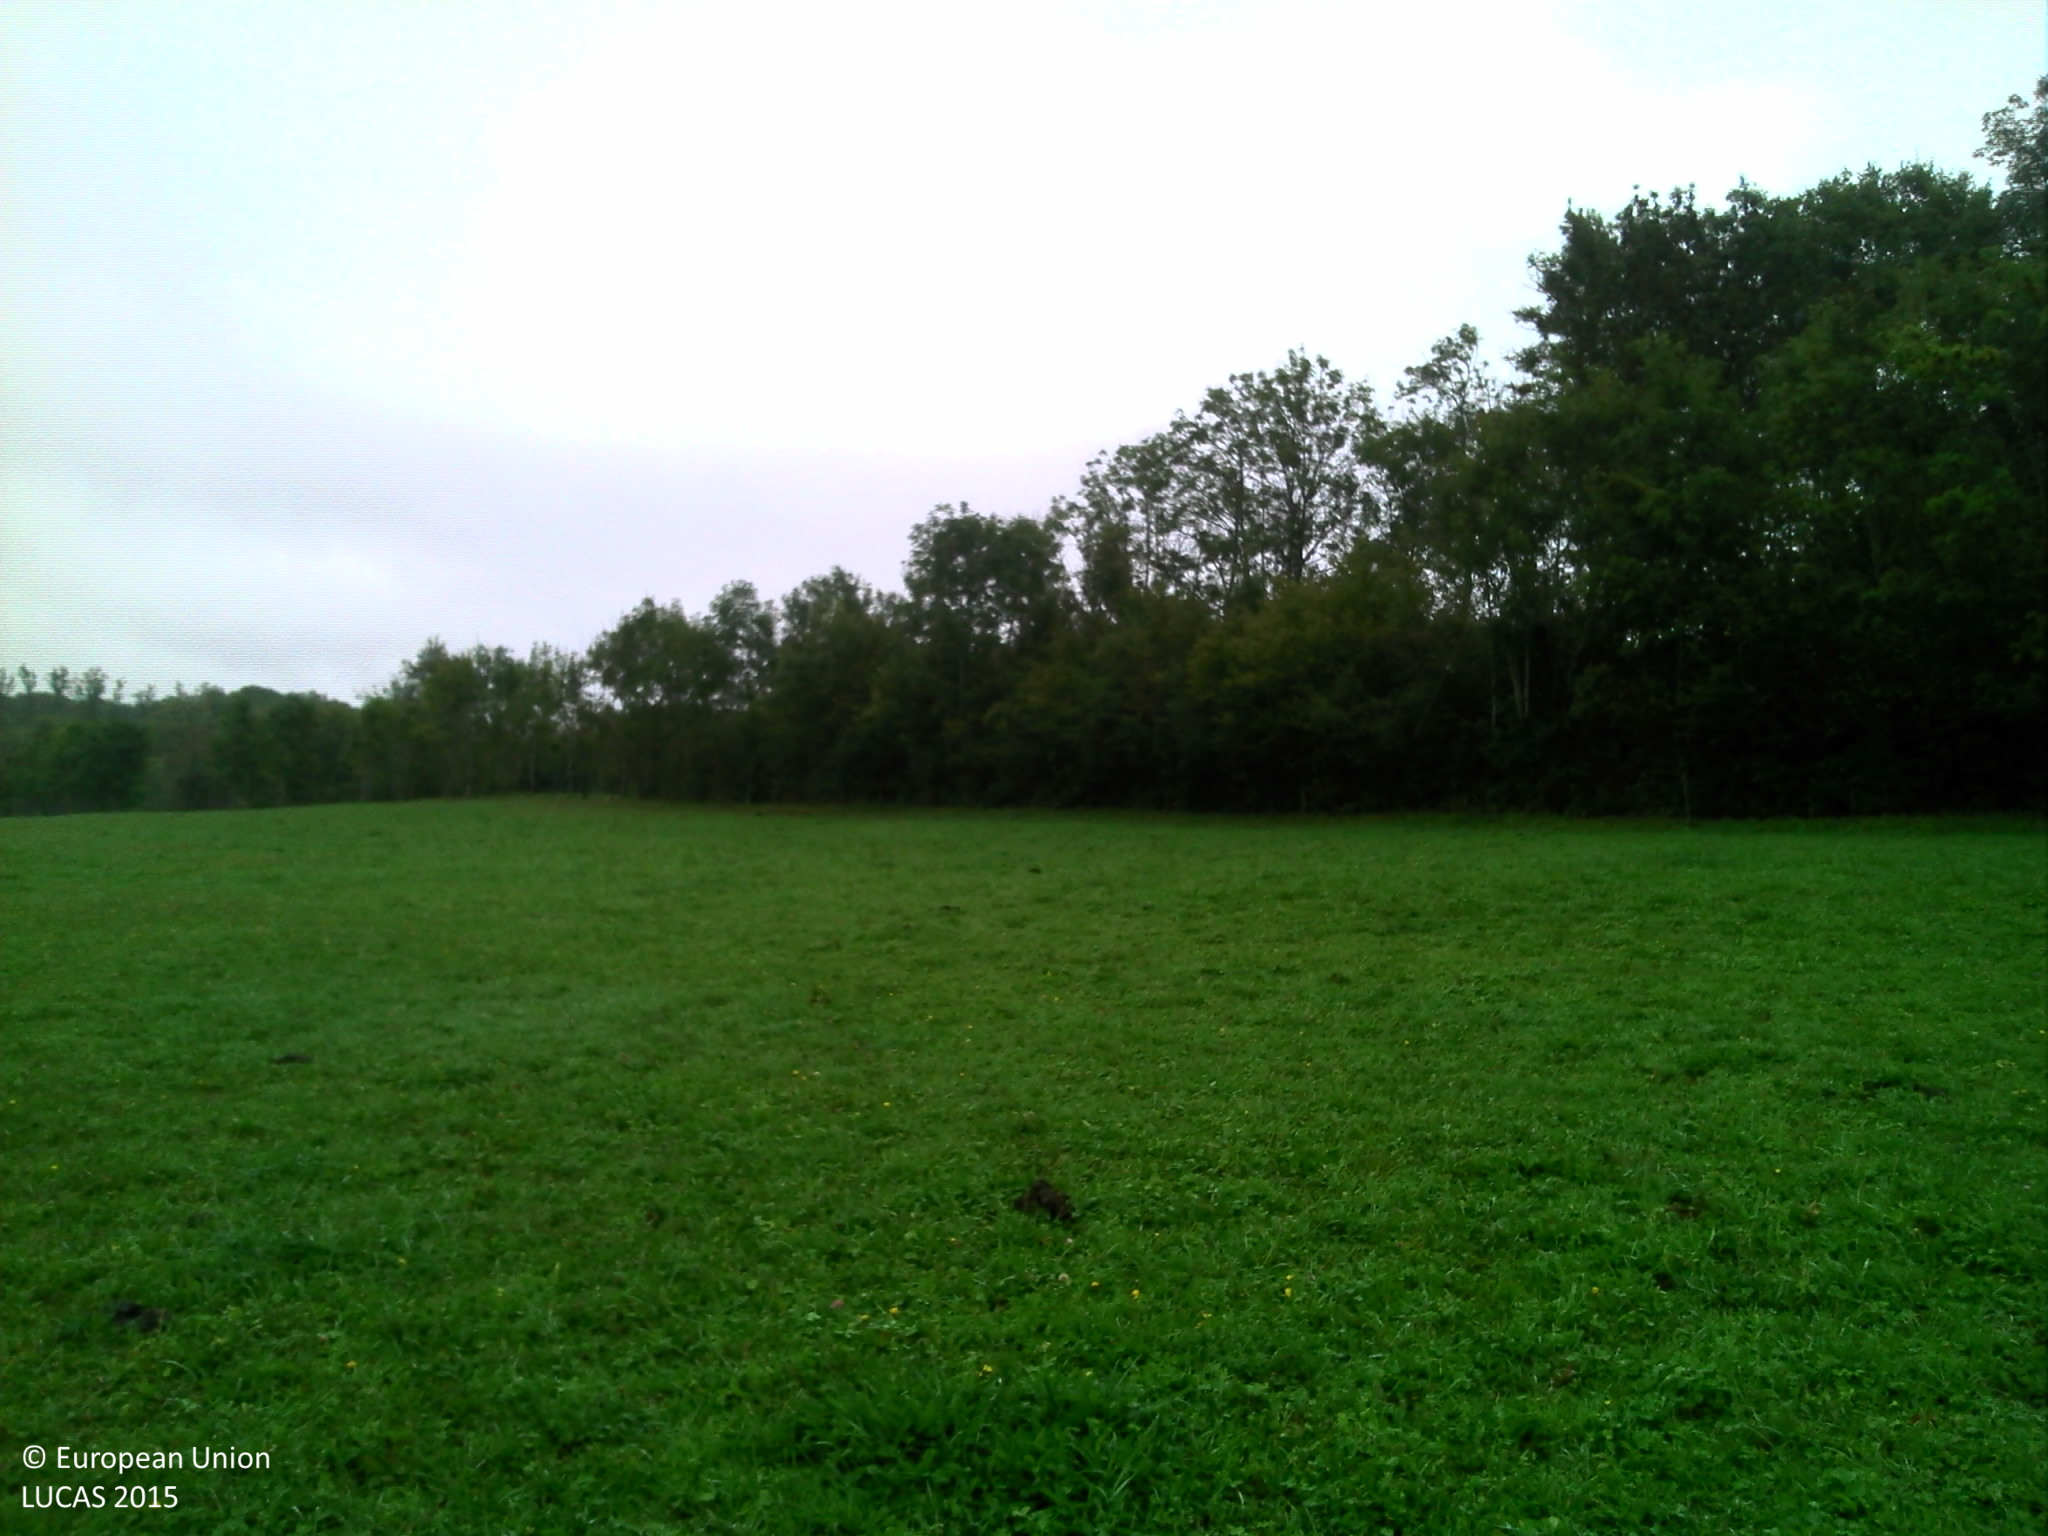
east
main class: Grassland
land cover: Grassland without tree/shrub cover
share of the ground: > 75 %
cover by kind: herbaceous plants 100 %
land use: Agriculture (excluding fallow land and kitchen gardens)
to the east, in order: Grassland without tree/shrub cover; Fences; Broadleaved woodland; Electric lines; Grass margins; Paved roads, cycling and walking lanes; Grass margins; Ditches and canals; Broadleaved woodland; Fences; Grassland without tree/shrub cover
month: September
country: FR
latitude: 47.0702
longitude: 4.7463
